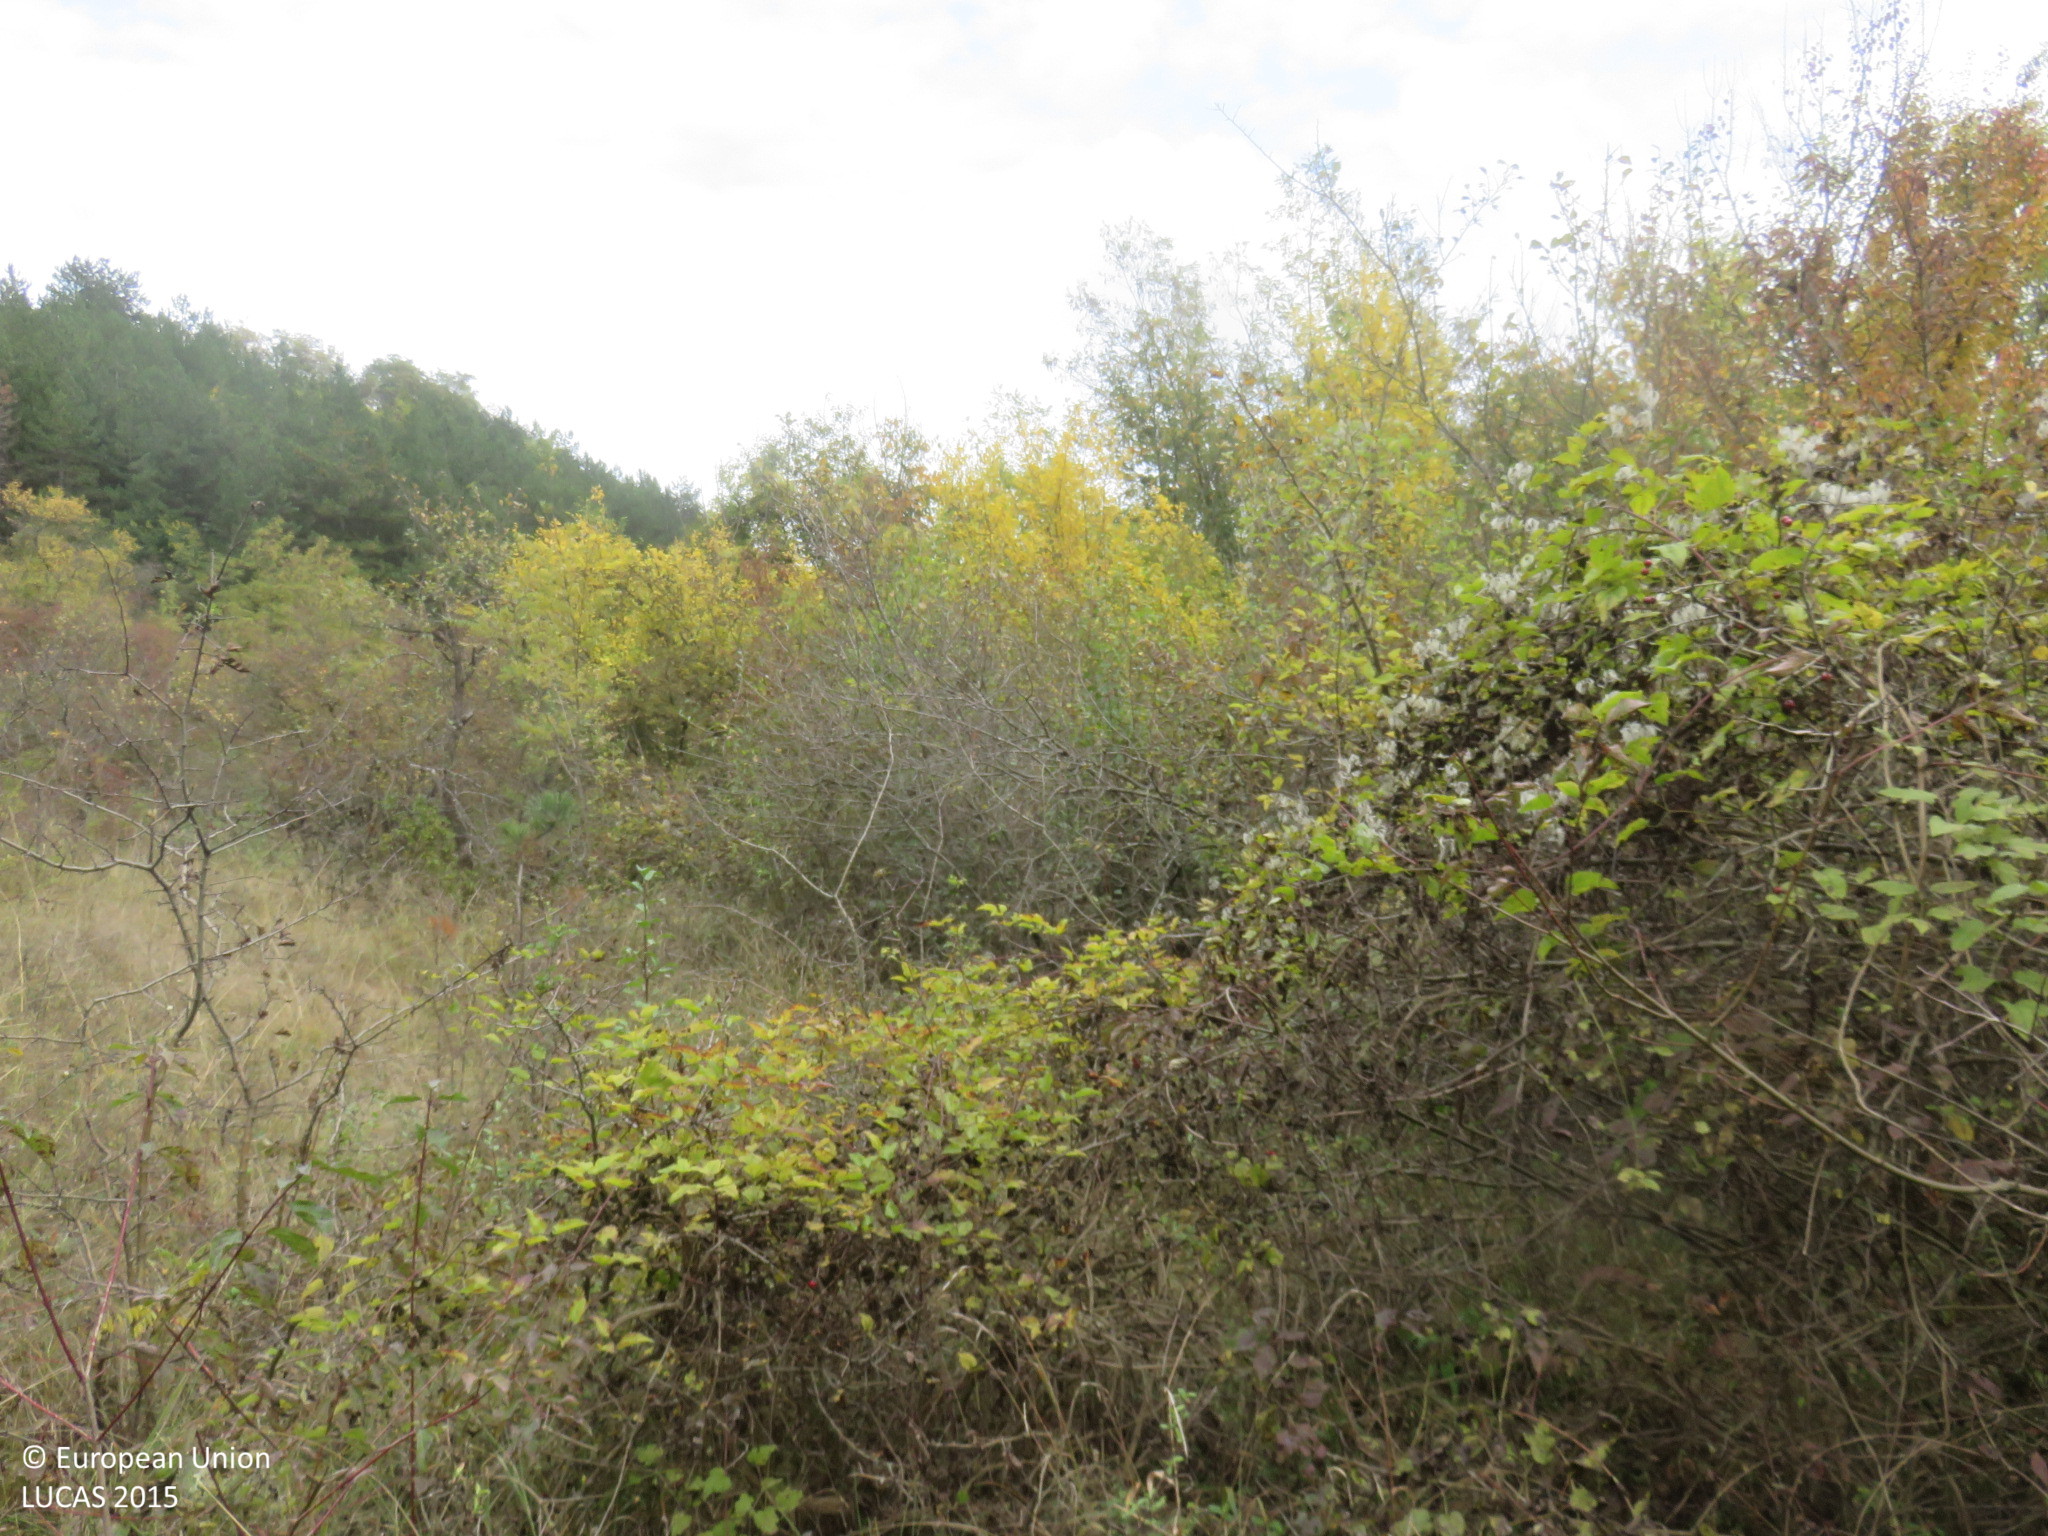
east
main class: Shrubland
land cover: Shrubland with sparse tree cover
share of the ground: > 75 %
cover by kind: shrubs 85 %, herbaceous plants 10 %, broadleaved forest trees 5 %
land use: Semi-natural and natural areas not in use
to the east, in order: Shrubland with sparse tree cover; Broadleaved woodland; Tracks; Grassland with sparse tree/shrub cover; Shrubland with sparse tree cover; Broadleaved woodland; Shrubland with sparse tree cover
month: October
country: BG
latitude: 42.9973
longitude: 24.9936
